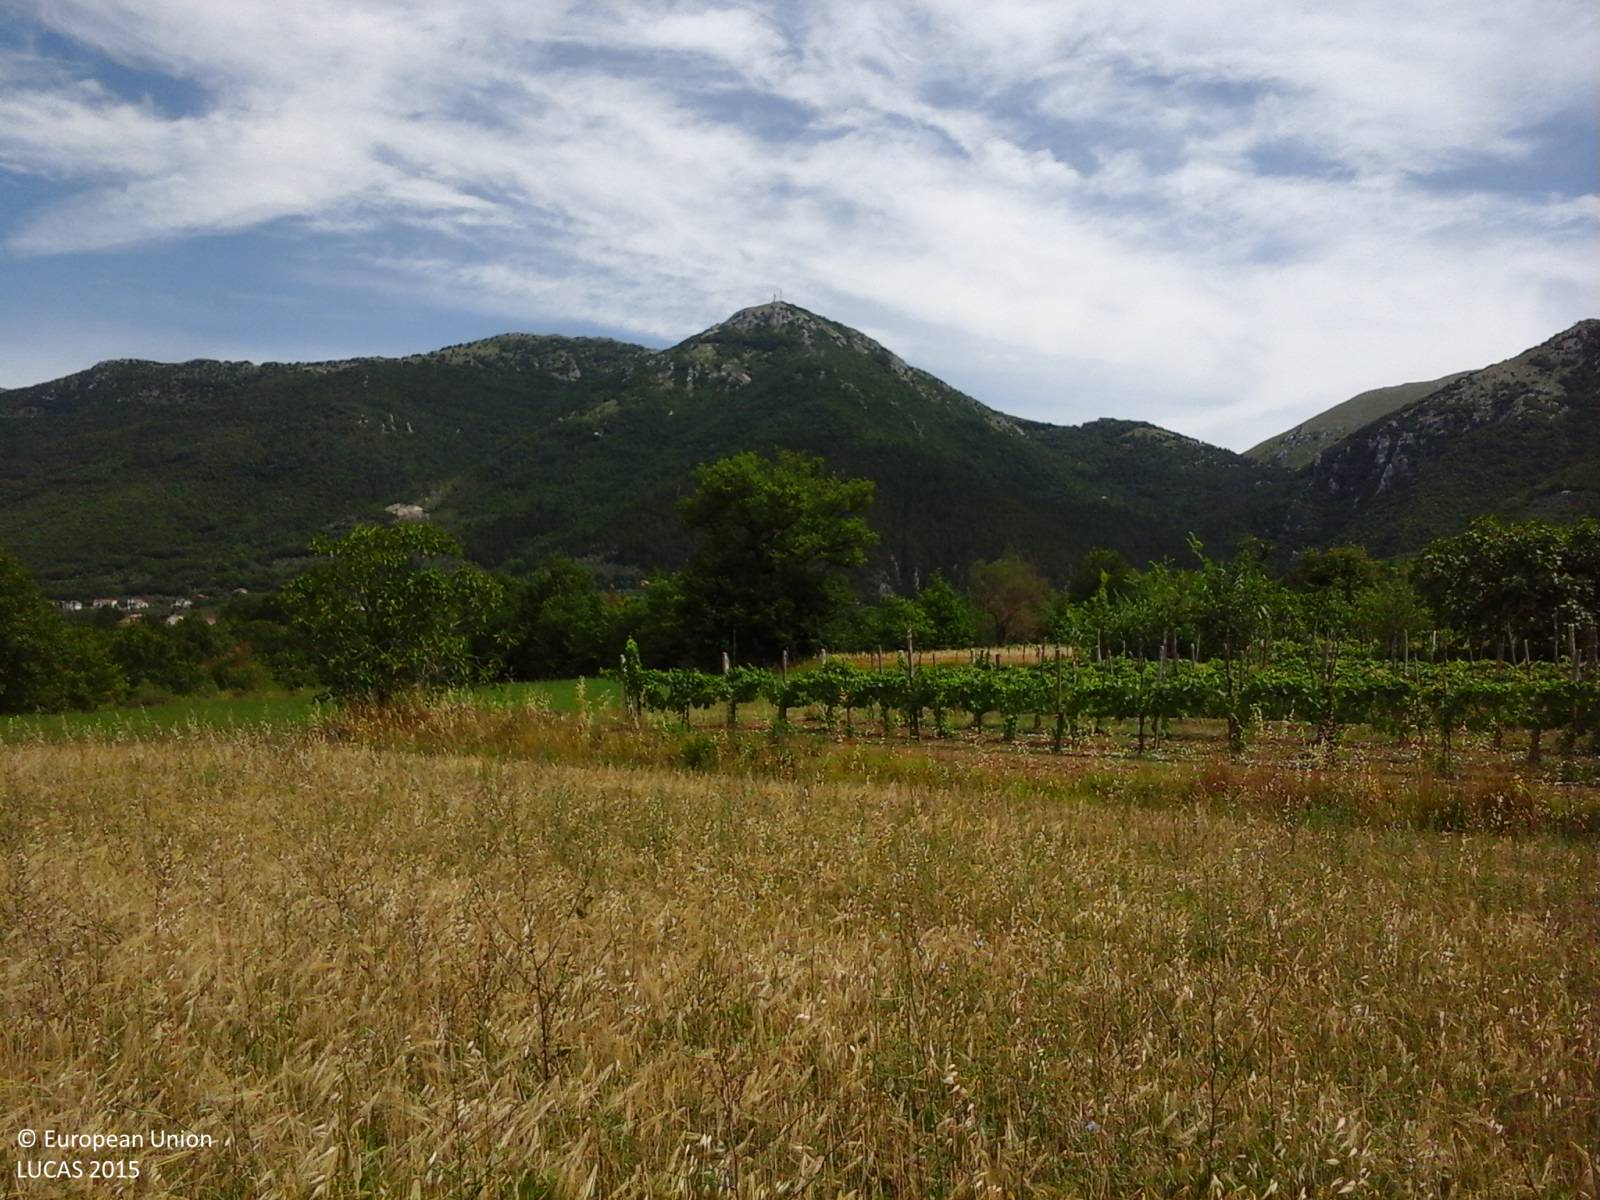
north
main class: Cropland
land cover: Barley
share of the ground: > 75 %
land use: Agriculture (excluding fallow land and kitchen gardens)
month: June
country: IT
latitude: 41.4458
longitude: 14.1858
